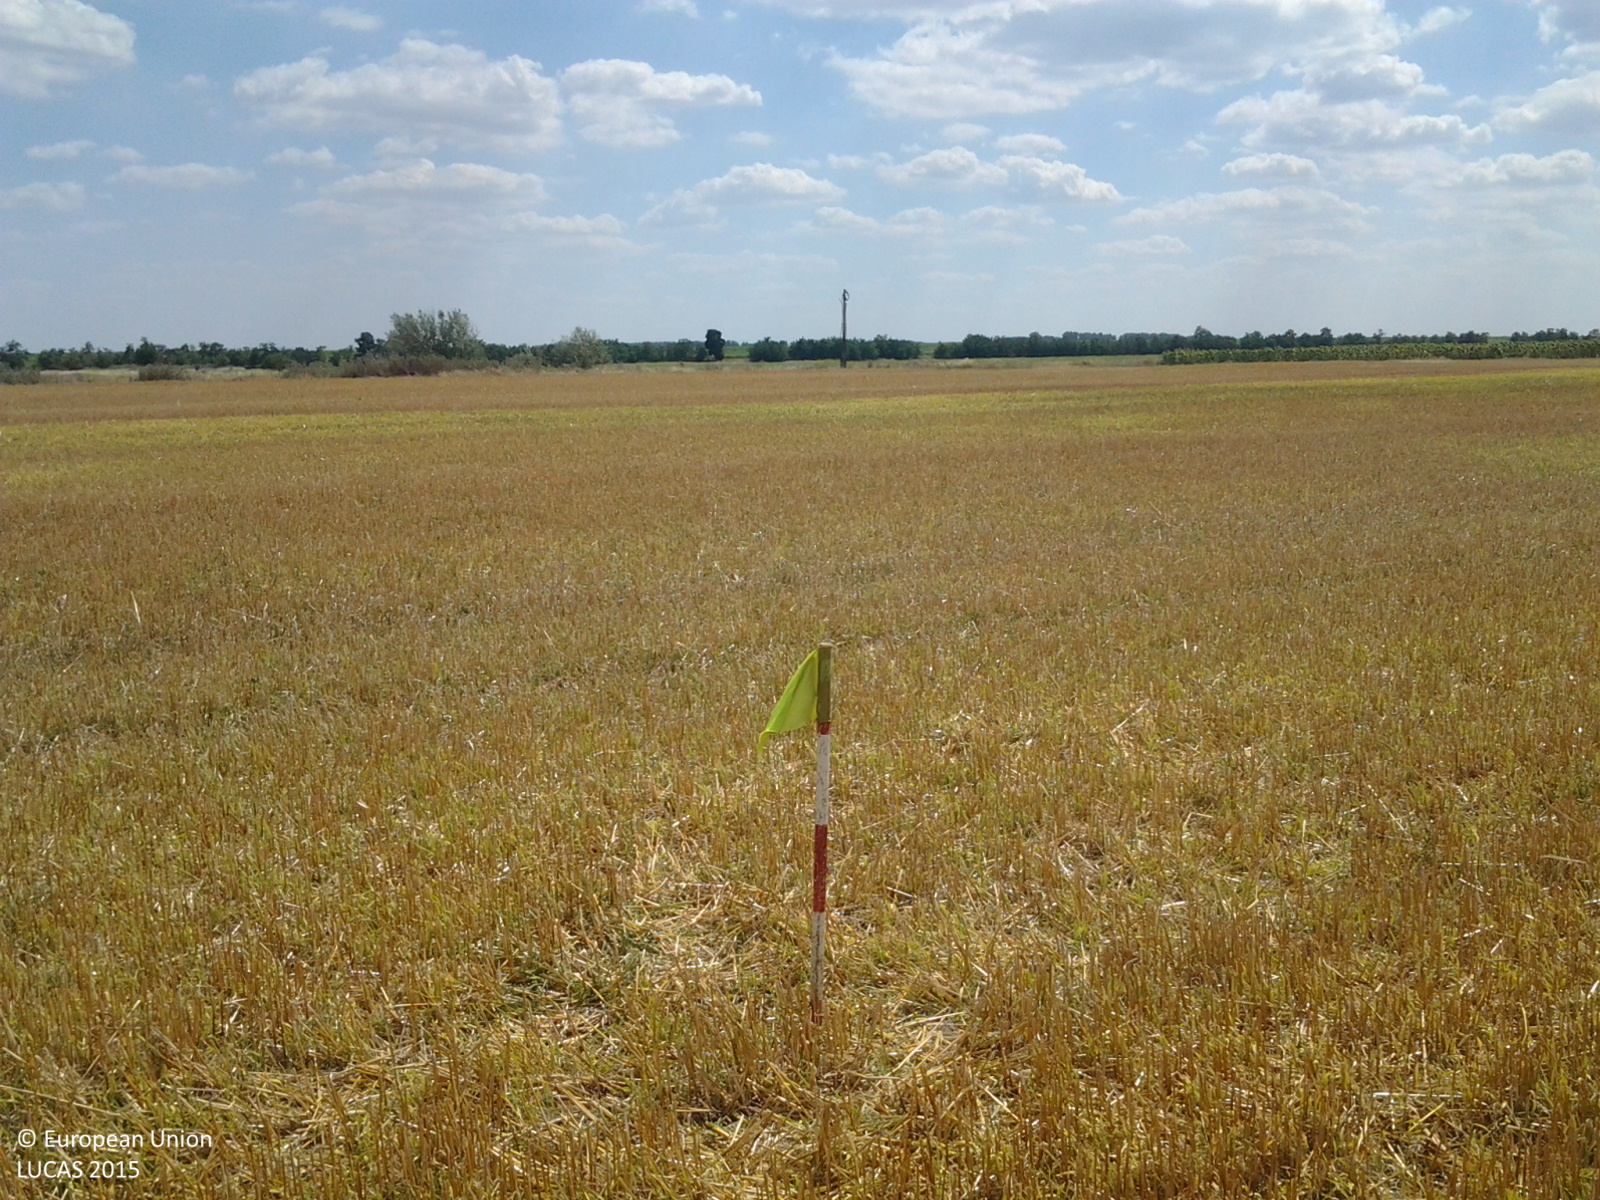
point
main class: Cropland
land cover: Barley
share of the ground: 10 - 25 %
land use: Agriculture (excluding fallow land and kitchen gardens)
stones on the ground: < 10 %
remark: Harvested field
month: July
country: HU
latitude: 47.3905
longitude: 20.5364
